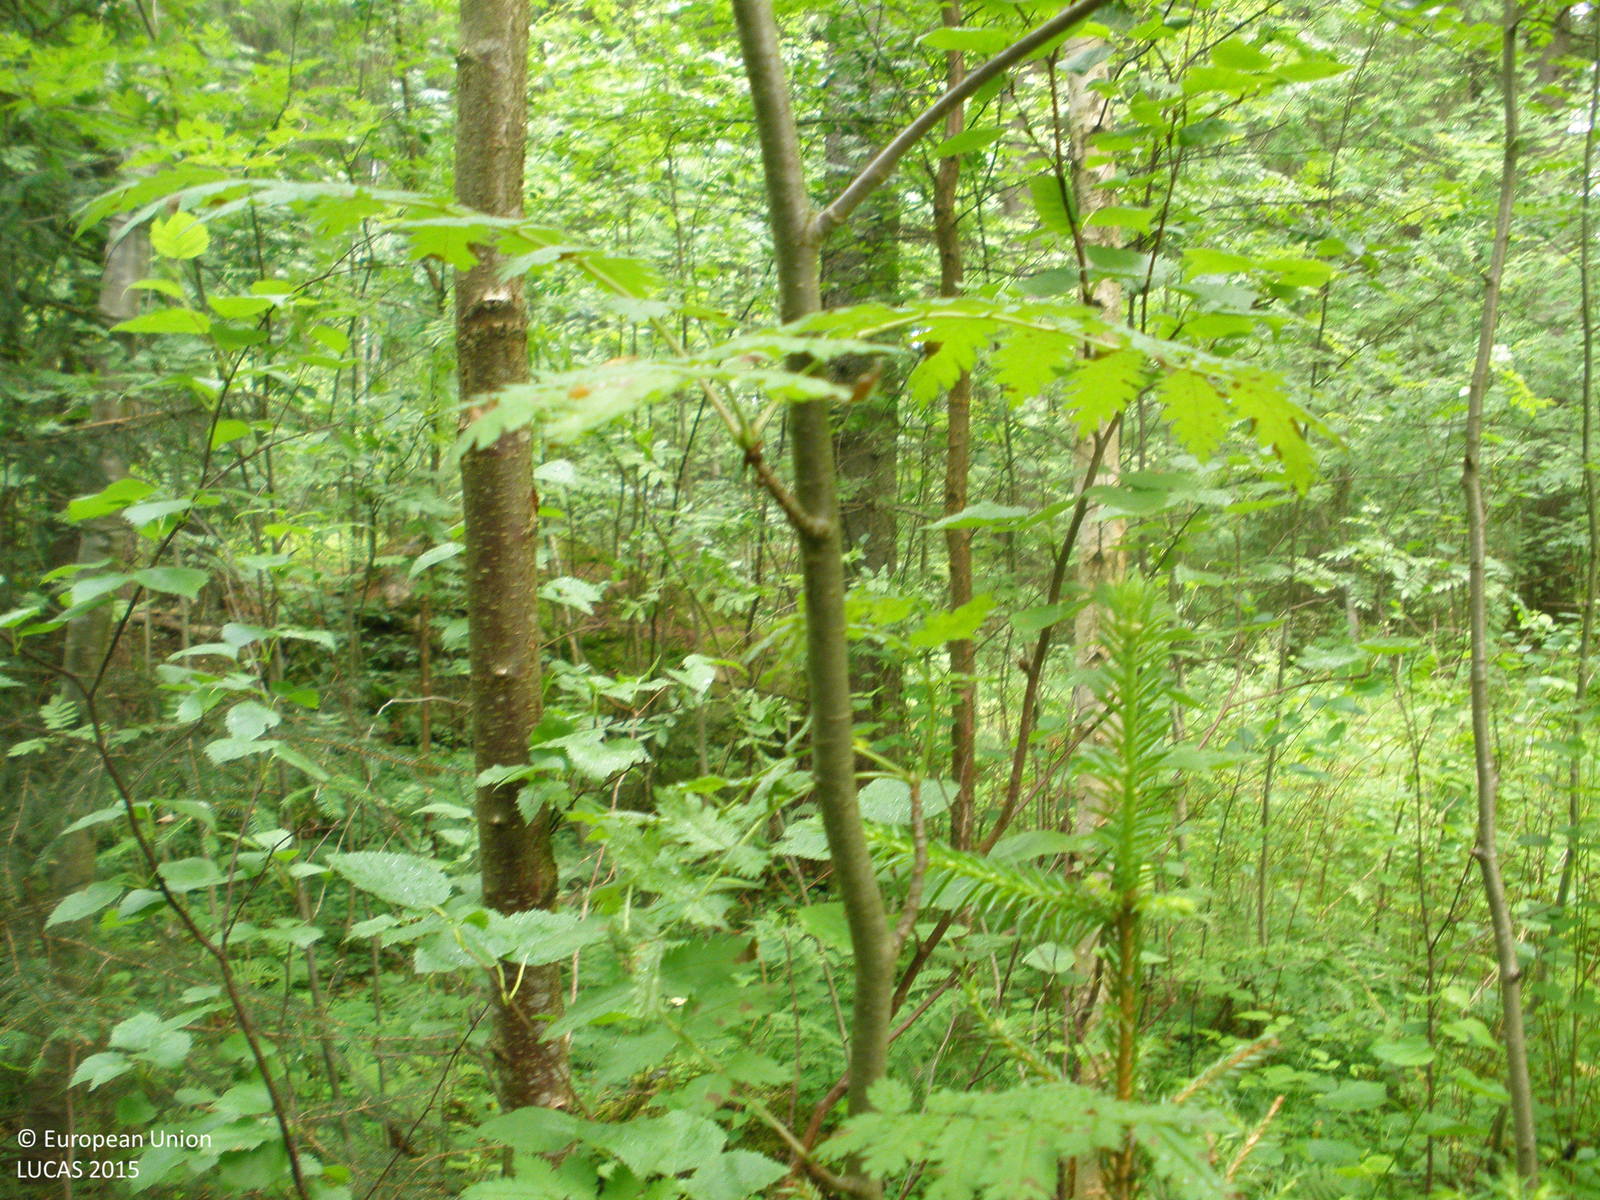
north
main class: Woodland
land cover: Broadleaved woodland
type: boreal forest
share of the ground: > 75 %
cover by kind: broadleaved forest trees 80 %, shrubs 10 %, coniferous forest trees 5 %, herbaceous plants 5 %
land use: Forestry
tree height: > 5 m
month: July
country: FI
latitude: 61.4343
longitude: 24.0568
